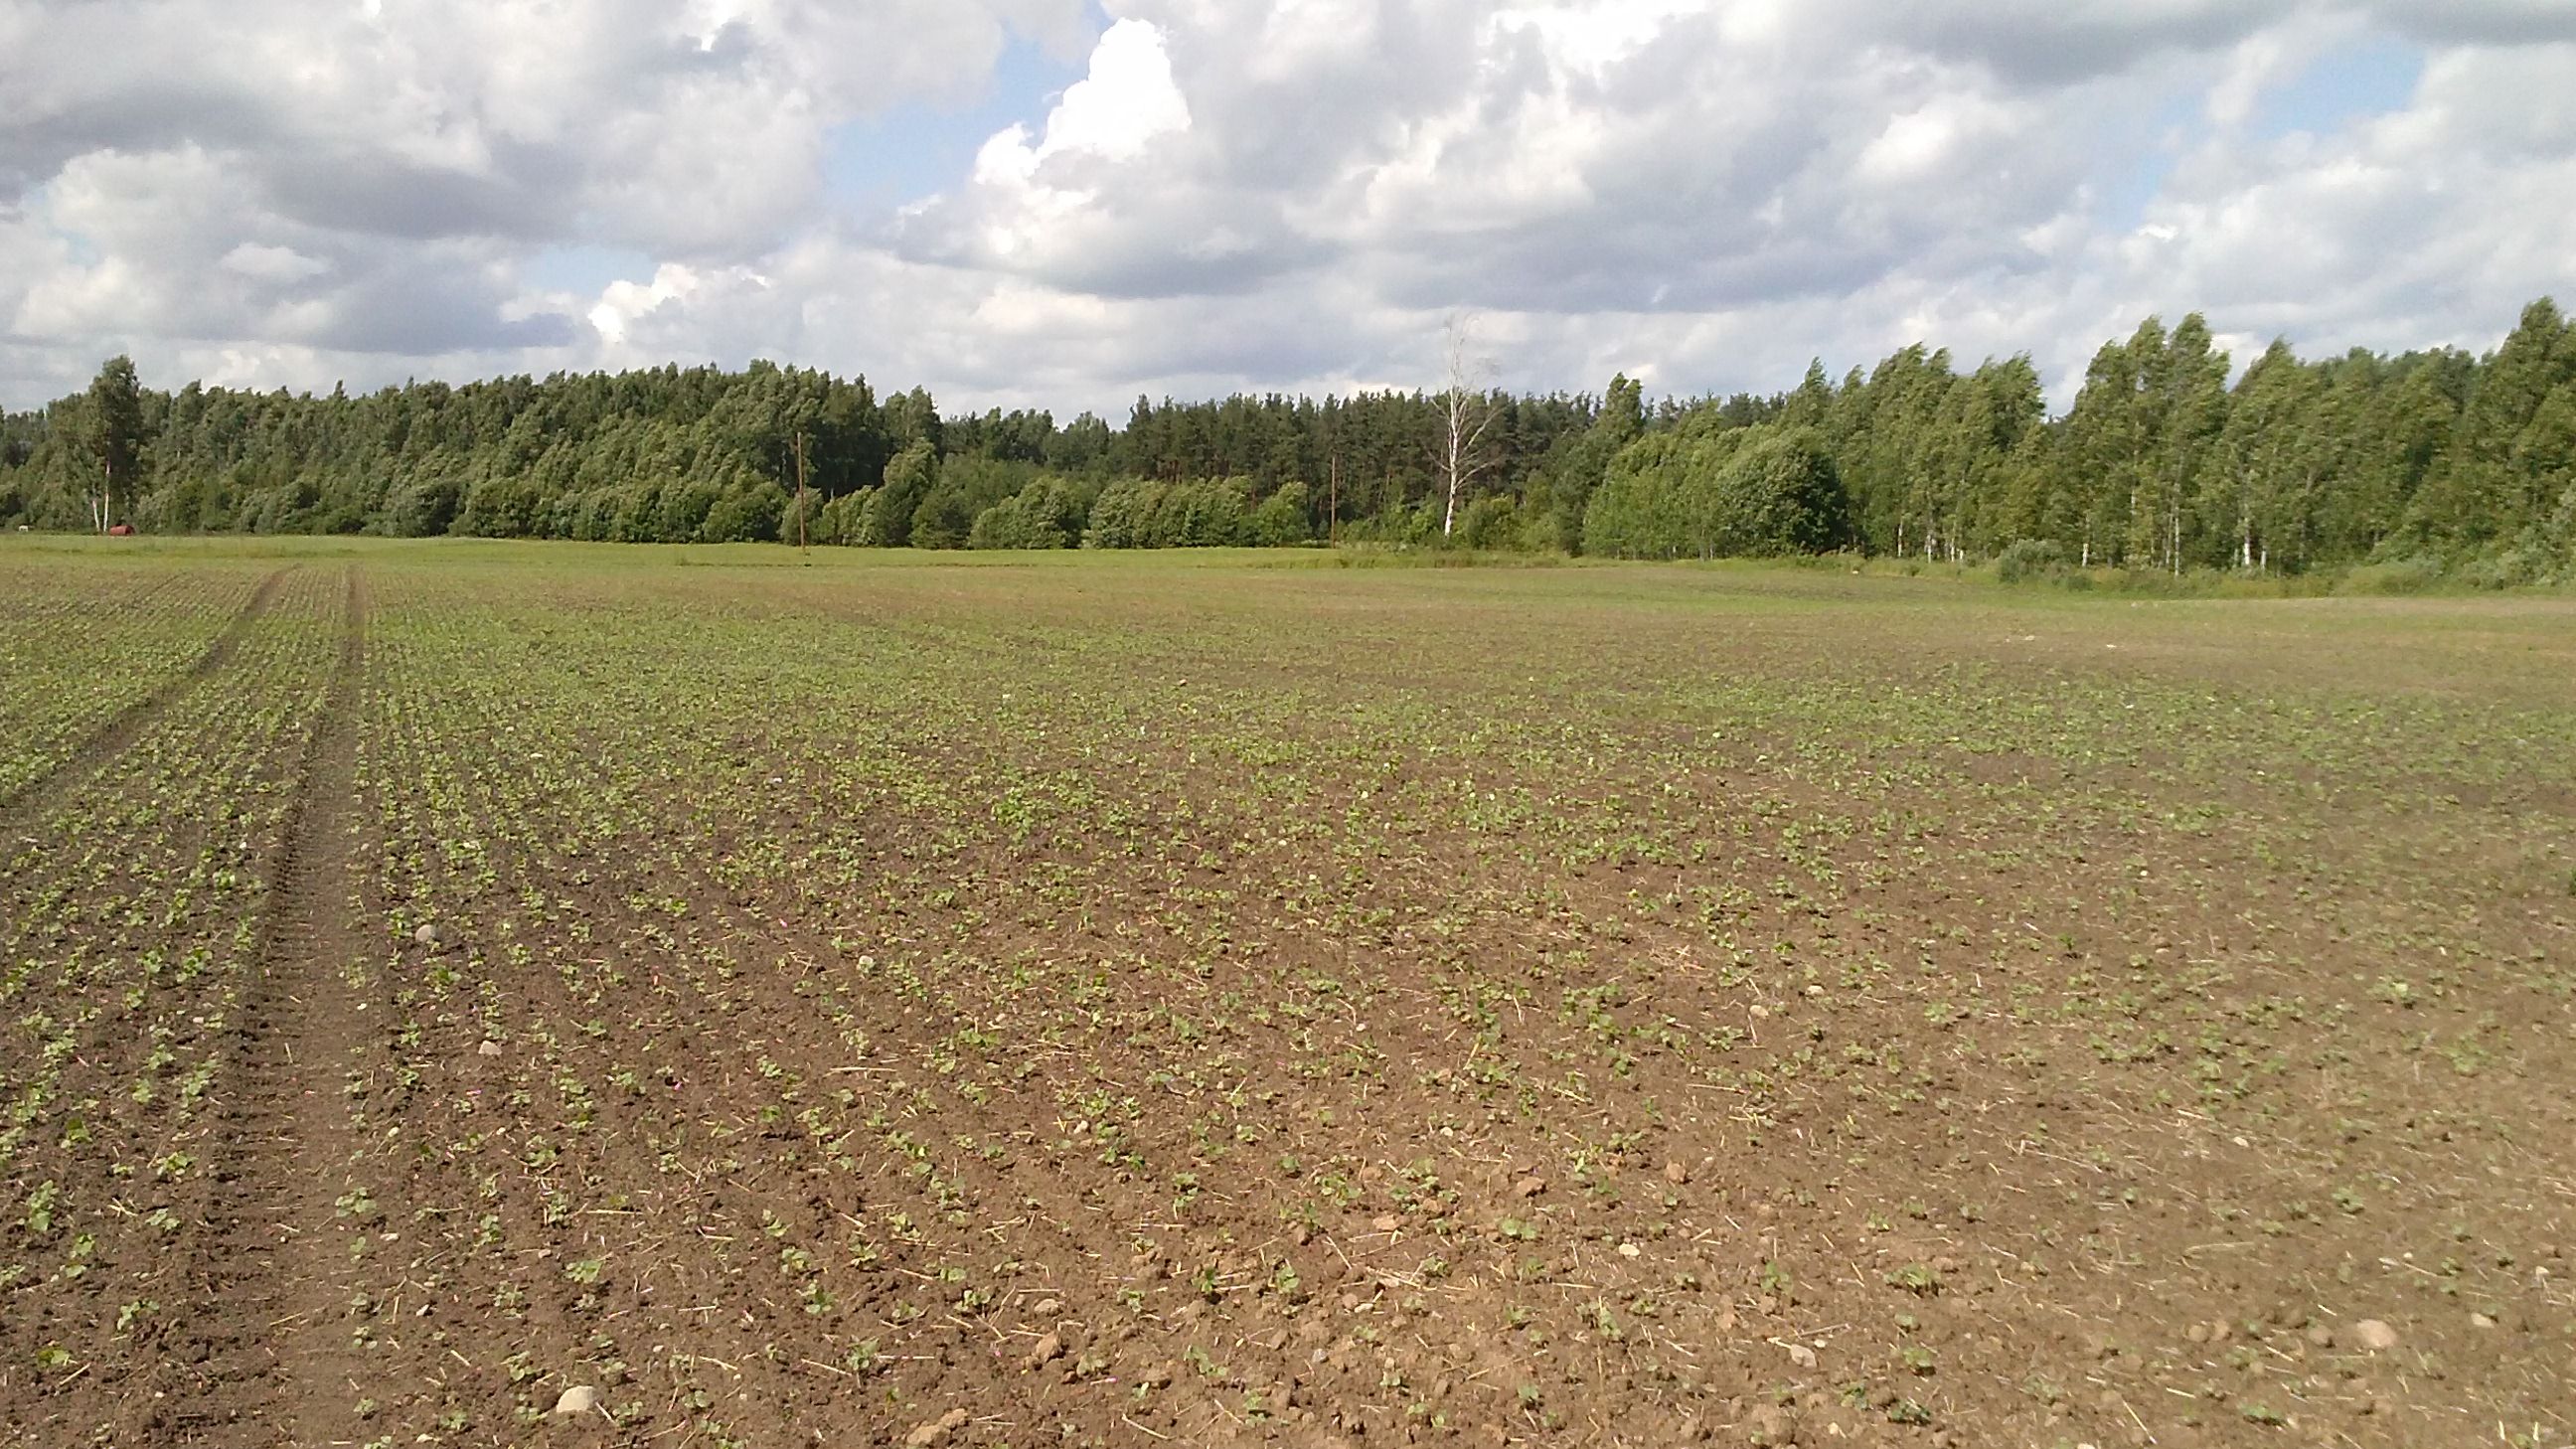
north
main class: Cropland
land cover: Other cereals
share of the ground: < 10 %
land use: Agriculture (excluding fallow land and kitchen gardens)
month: July
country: LV
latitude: 56.5397
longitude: 27.4984
